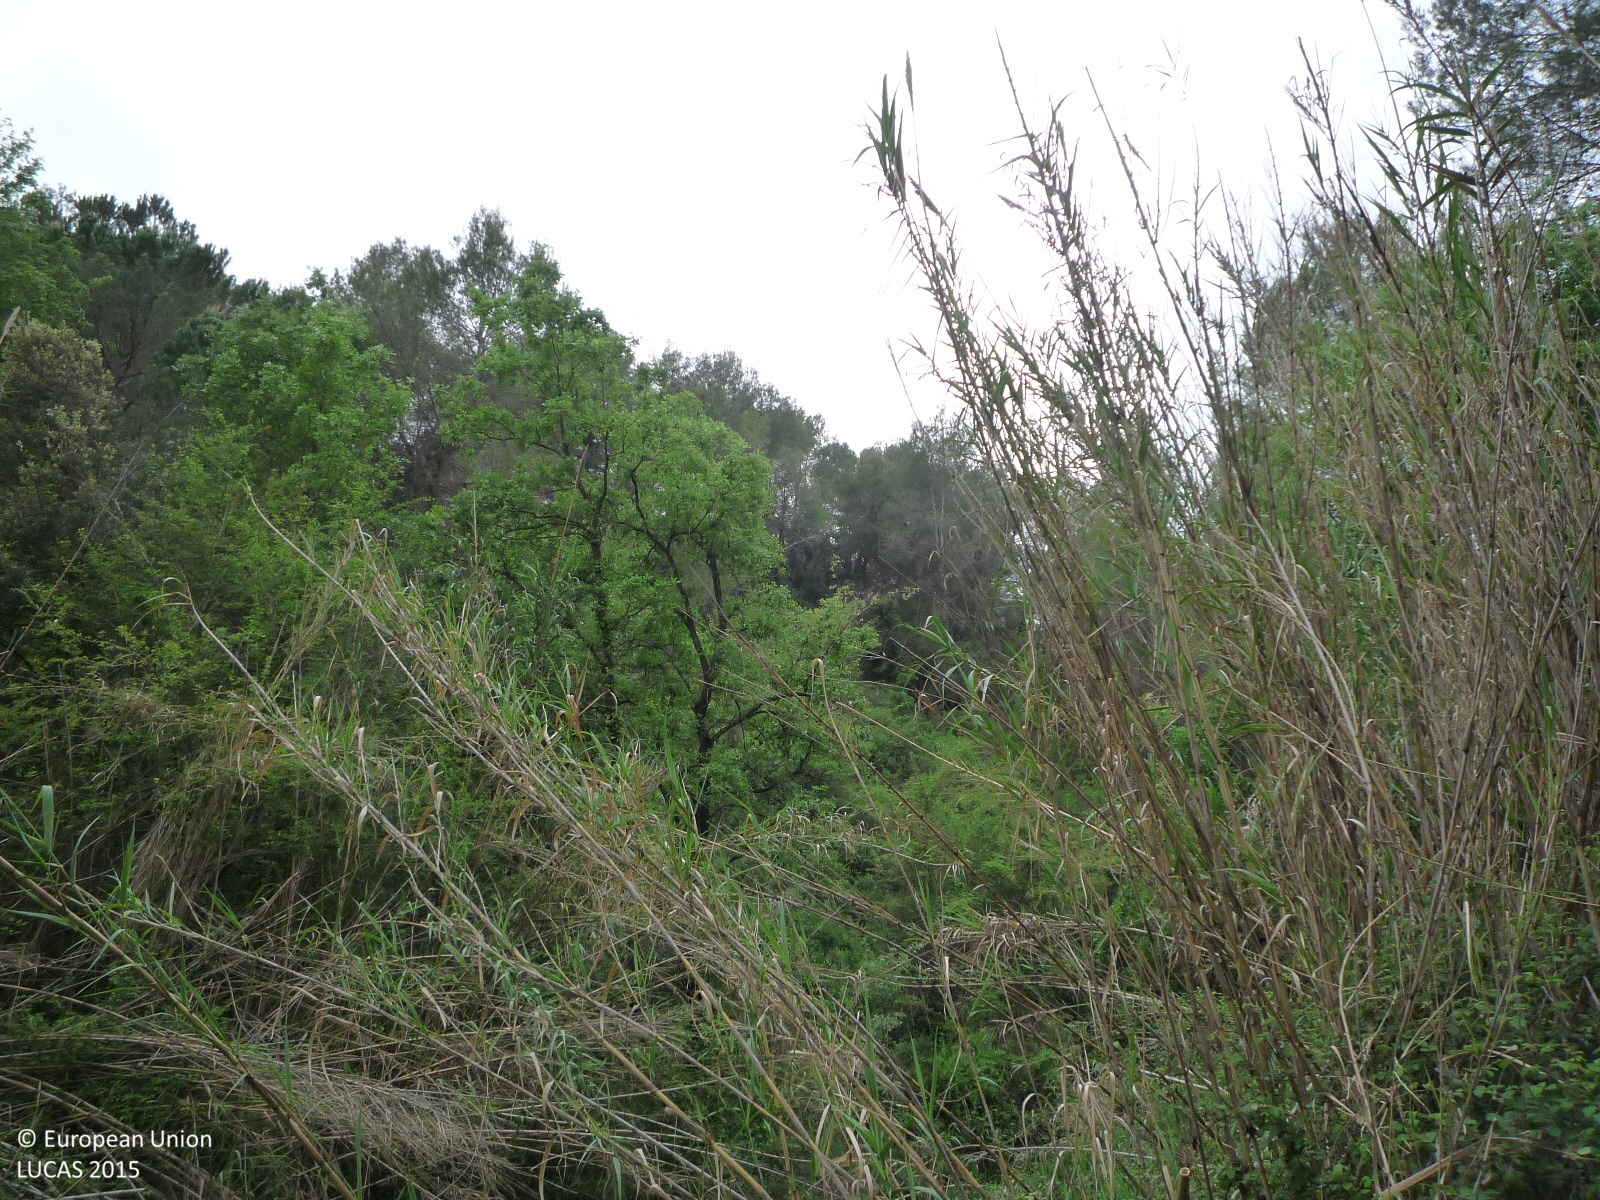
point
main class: Woodland
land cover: Pine dominated coniferous woodland
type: coniferous forest of the mediterranean region
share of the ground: > 75 %
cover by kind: coniferous forest trees 100 %
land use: Semi-natural and natural areas not in use
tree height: > 5 m
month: May
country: ES
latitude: 41.4872
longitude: 1.8124
